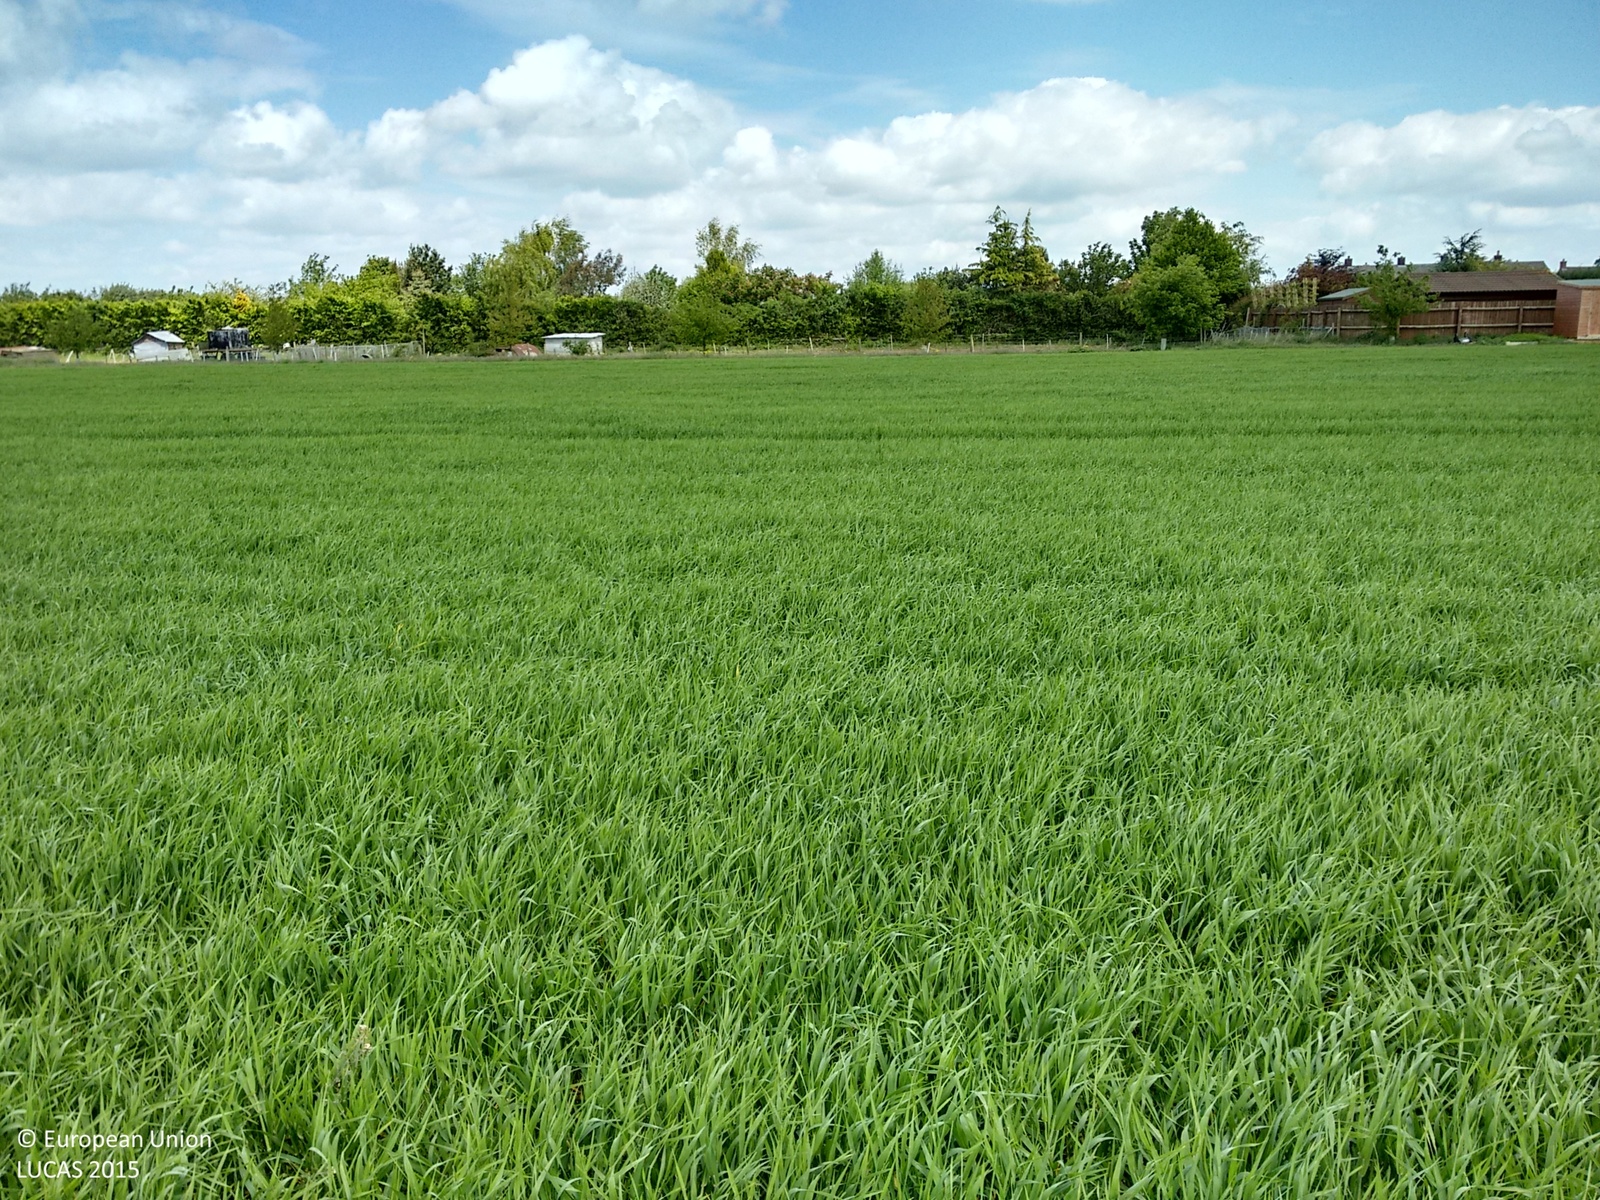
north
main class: Cropland
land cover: Barley
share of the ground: > 75 %
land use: Agriculture (excluding fallow land and kitchen gardens)
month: May
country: GB
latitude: 52.0739
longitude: -0.2926
